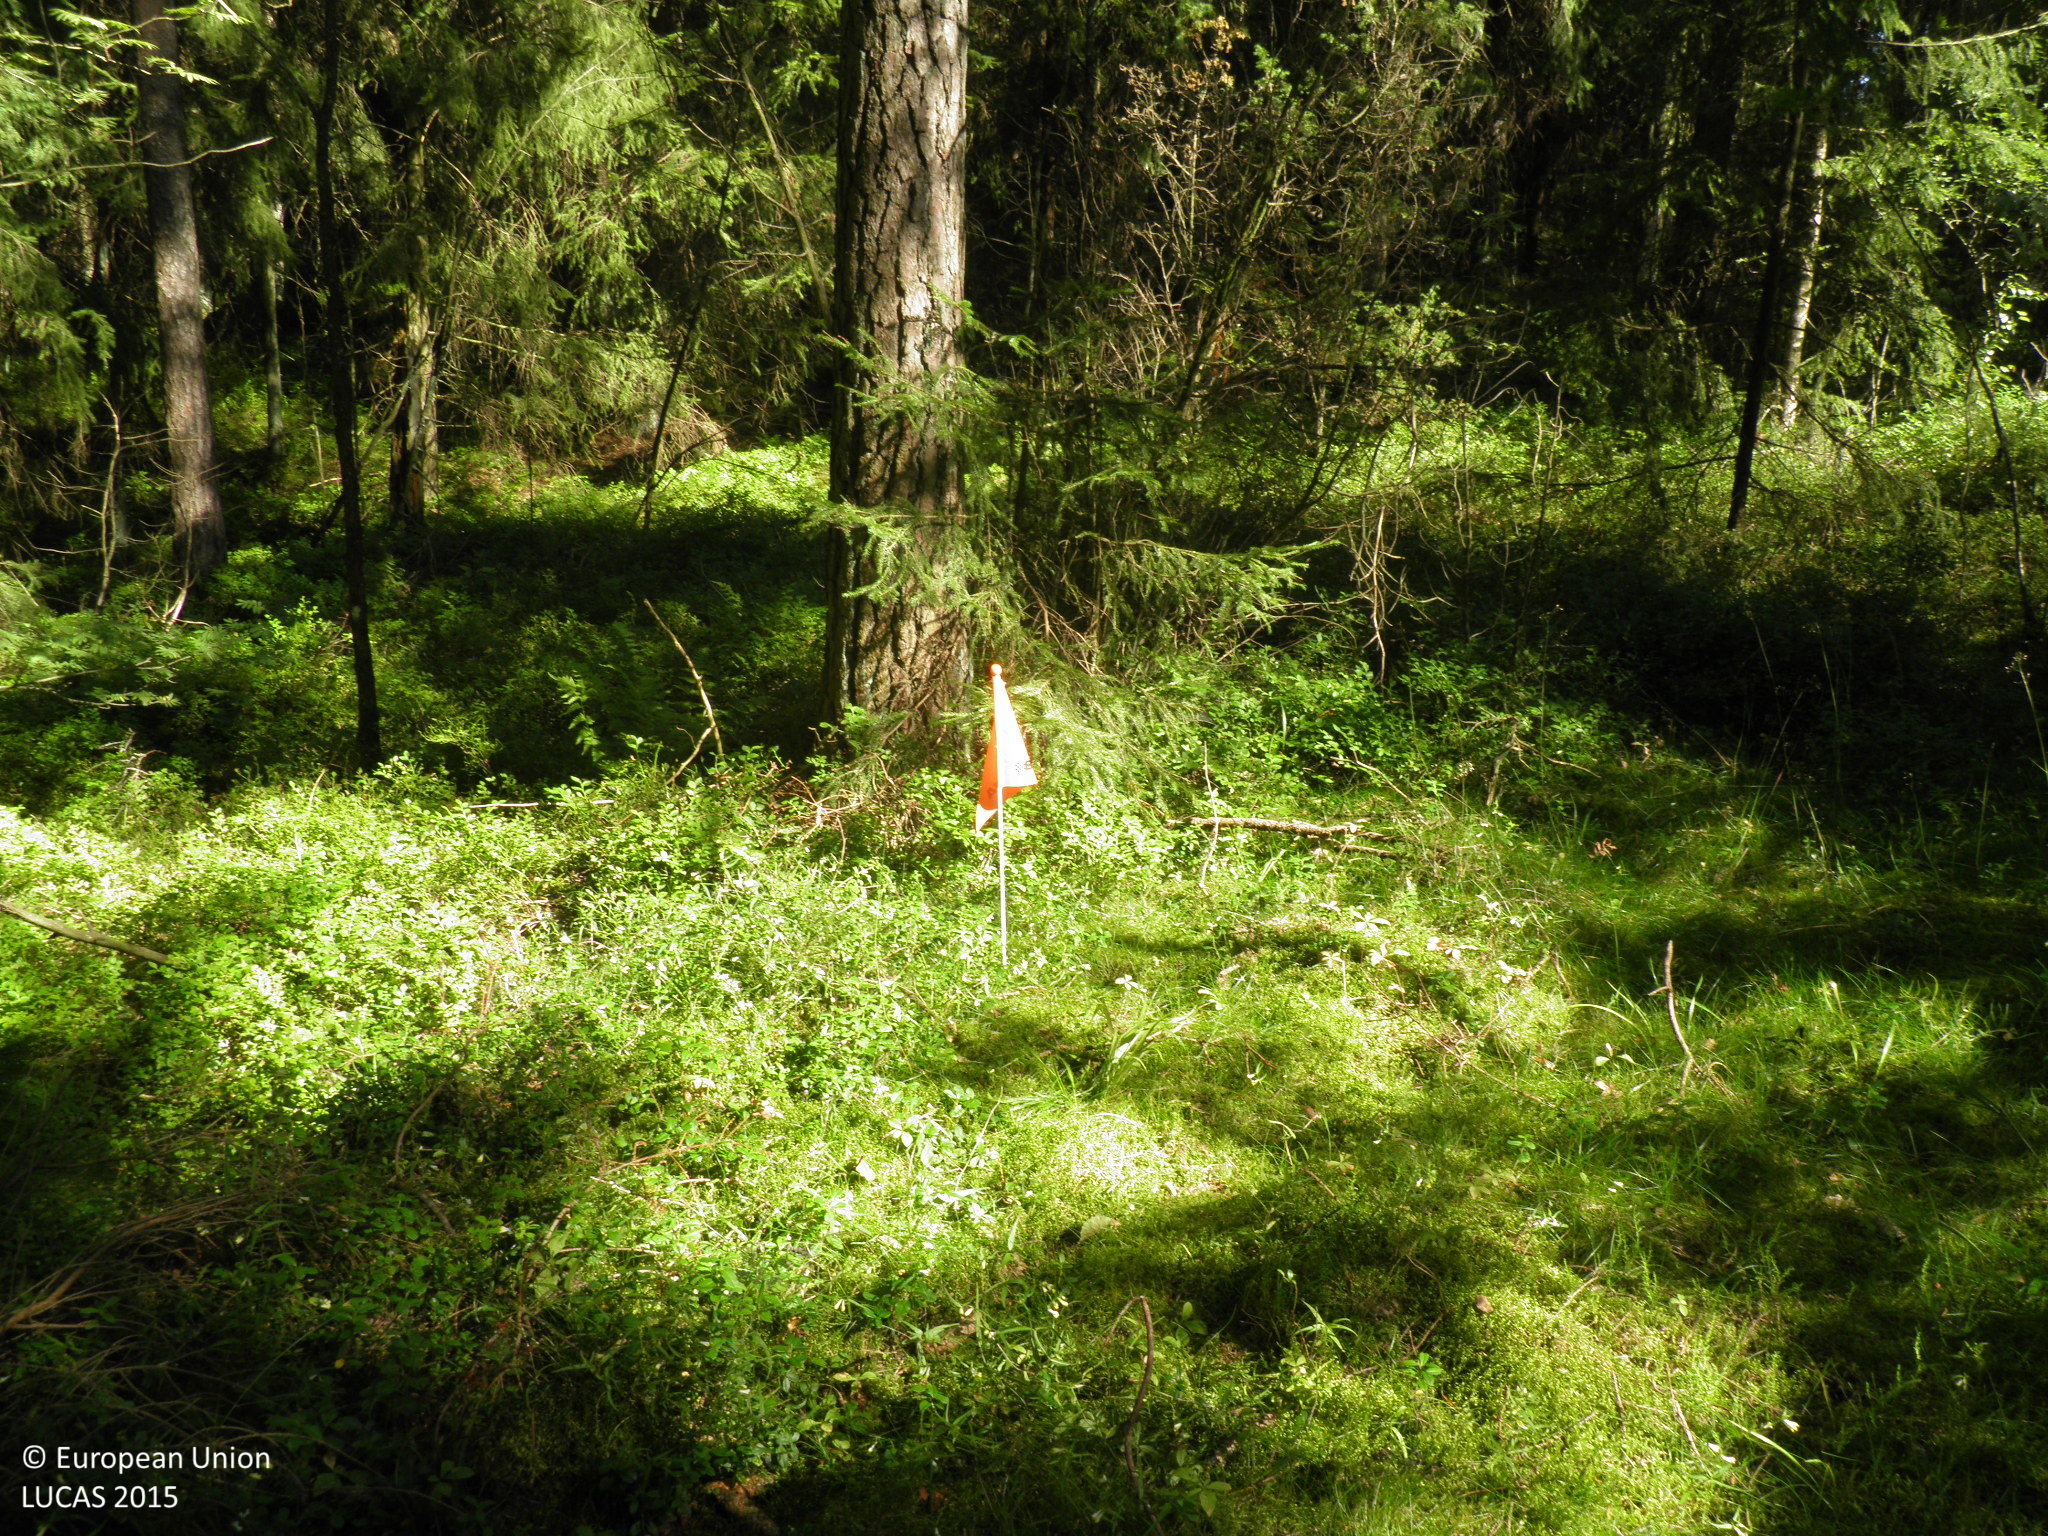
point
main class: Woodland
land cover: Spruce dominated coniferous woodland
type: hemiboreal forest and nemoral coniferous forest and mixed broadleaved-coniferous forest
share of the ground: 50 - 75 %
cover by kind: coniferous forest trees 50 %, shrubs 20 %, broadleaved forest trees 10 %, herbaceous plants 10 %, lichens and mosses 10 %
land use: Forestry
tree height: > 5 m
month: August
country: FI
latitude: 60.7161
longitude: 21.8815
